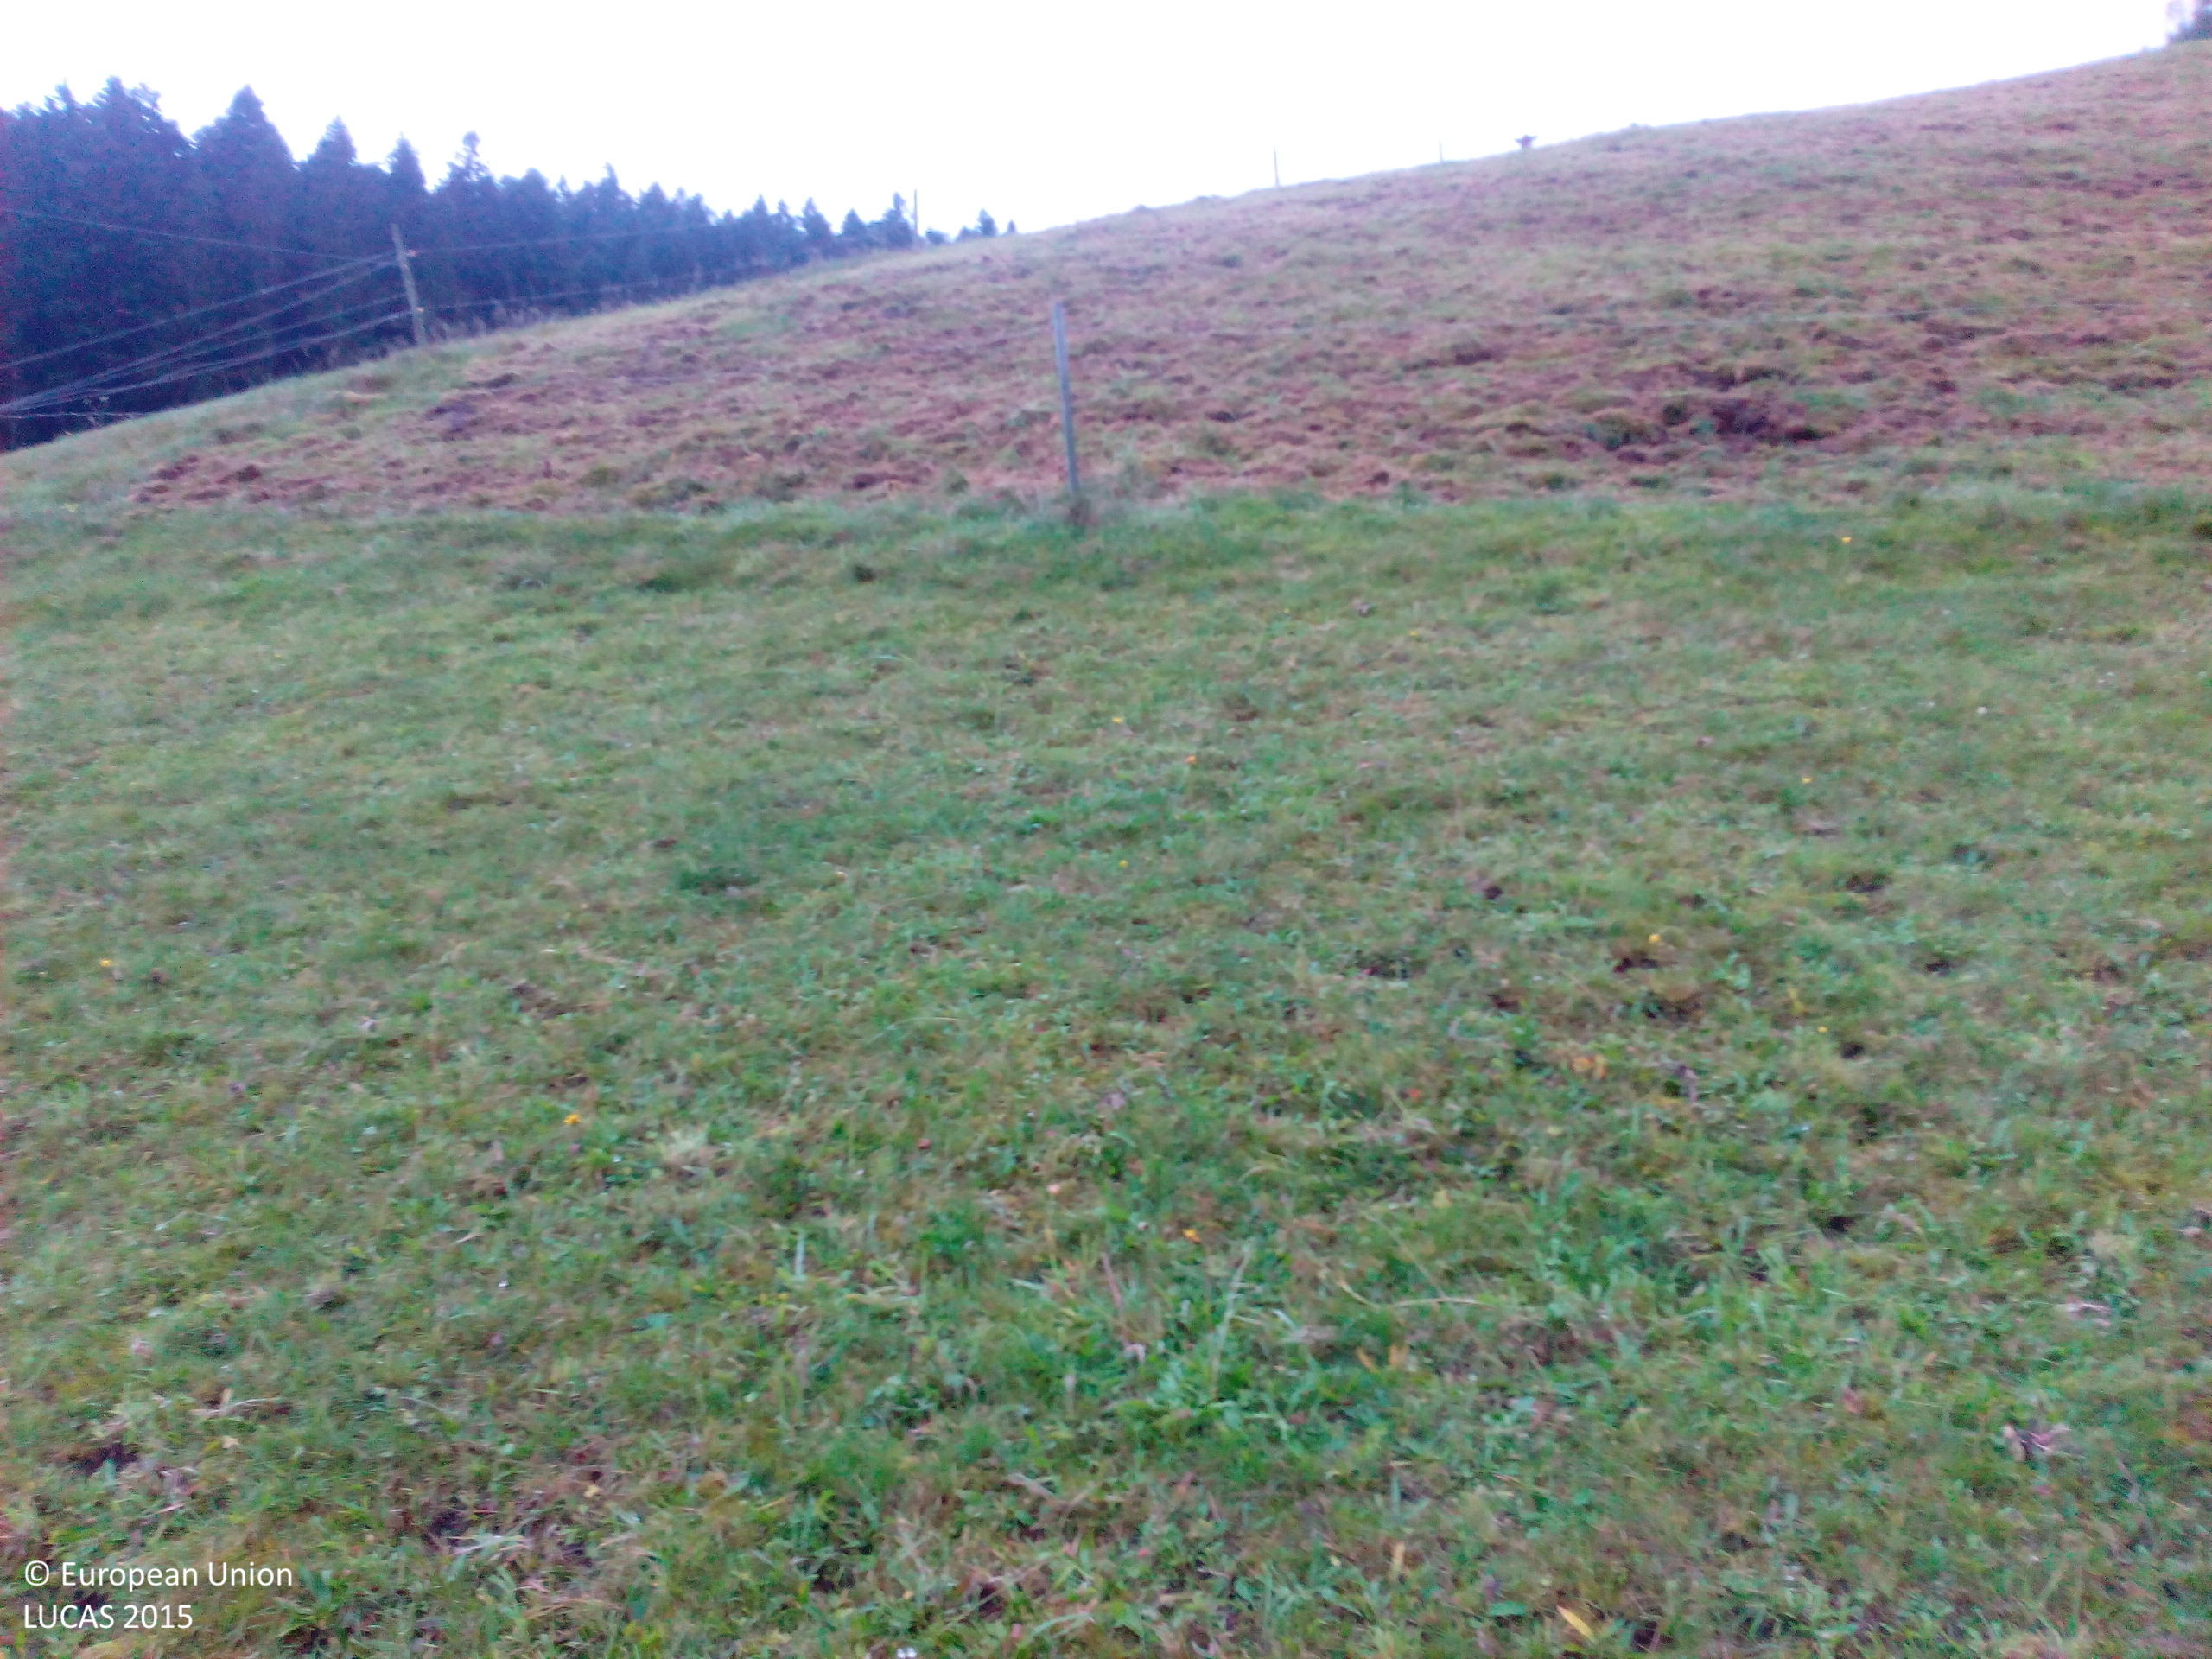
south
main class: Grassland
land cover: Grassland without tree/shrub cover
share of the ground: > 75 %
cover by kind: herbaceous plants 100 %
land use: Agriculture (excluding fallow land and kitchen gardens)
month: September
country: DE
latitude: 48.3709
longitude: 8.2054
